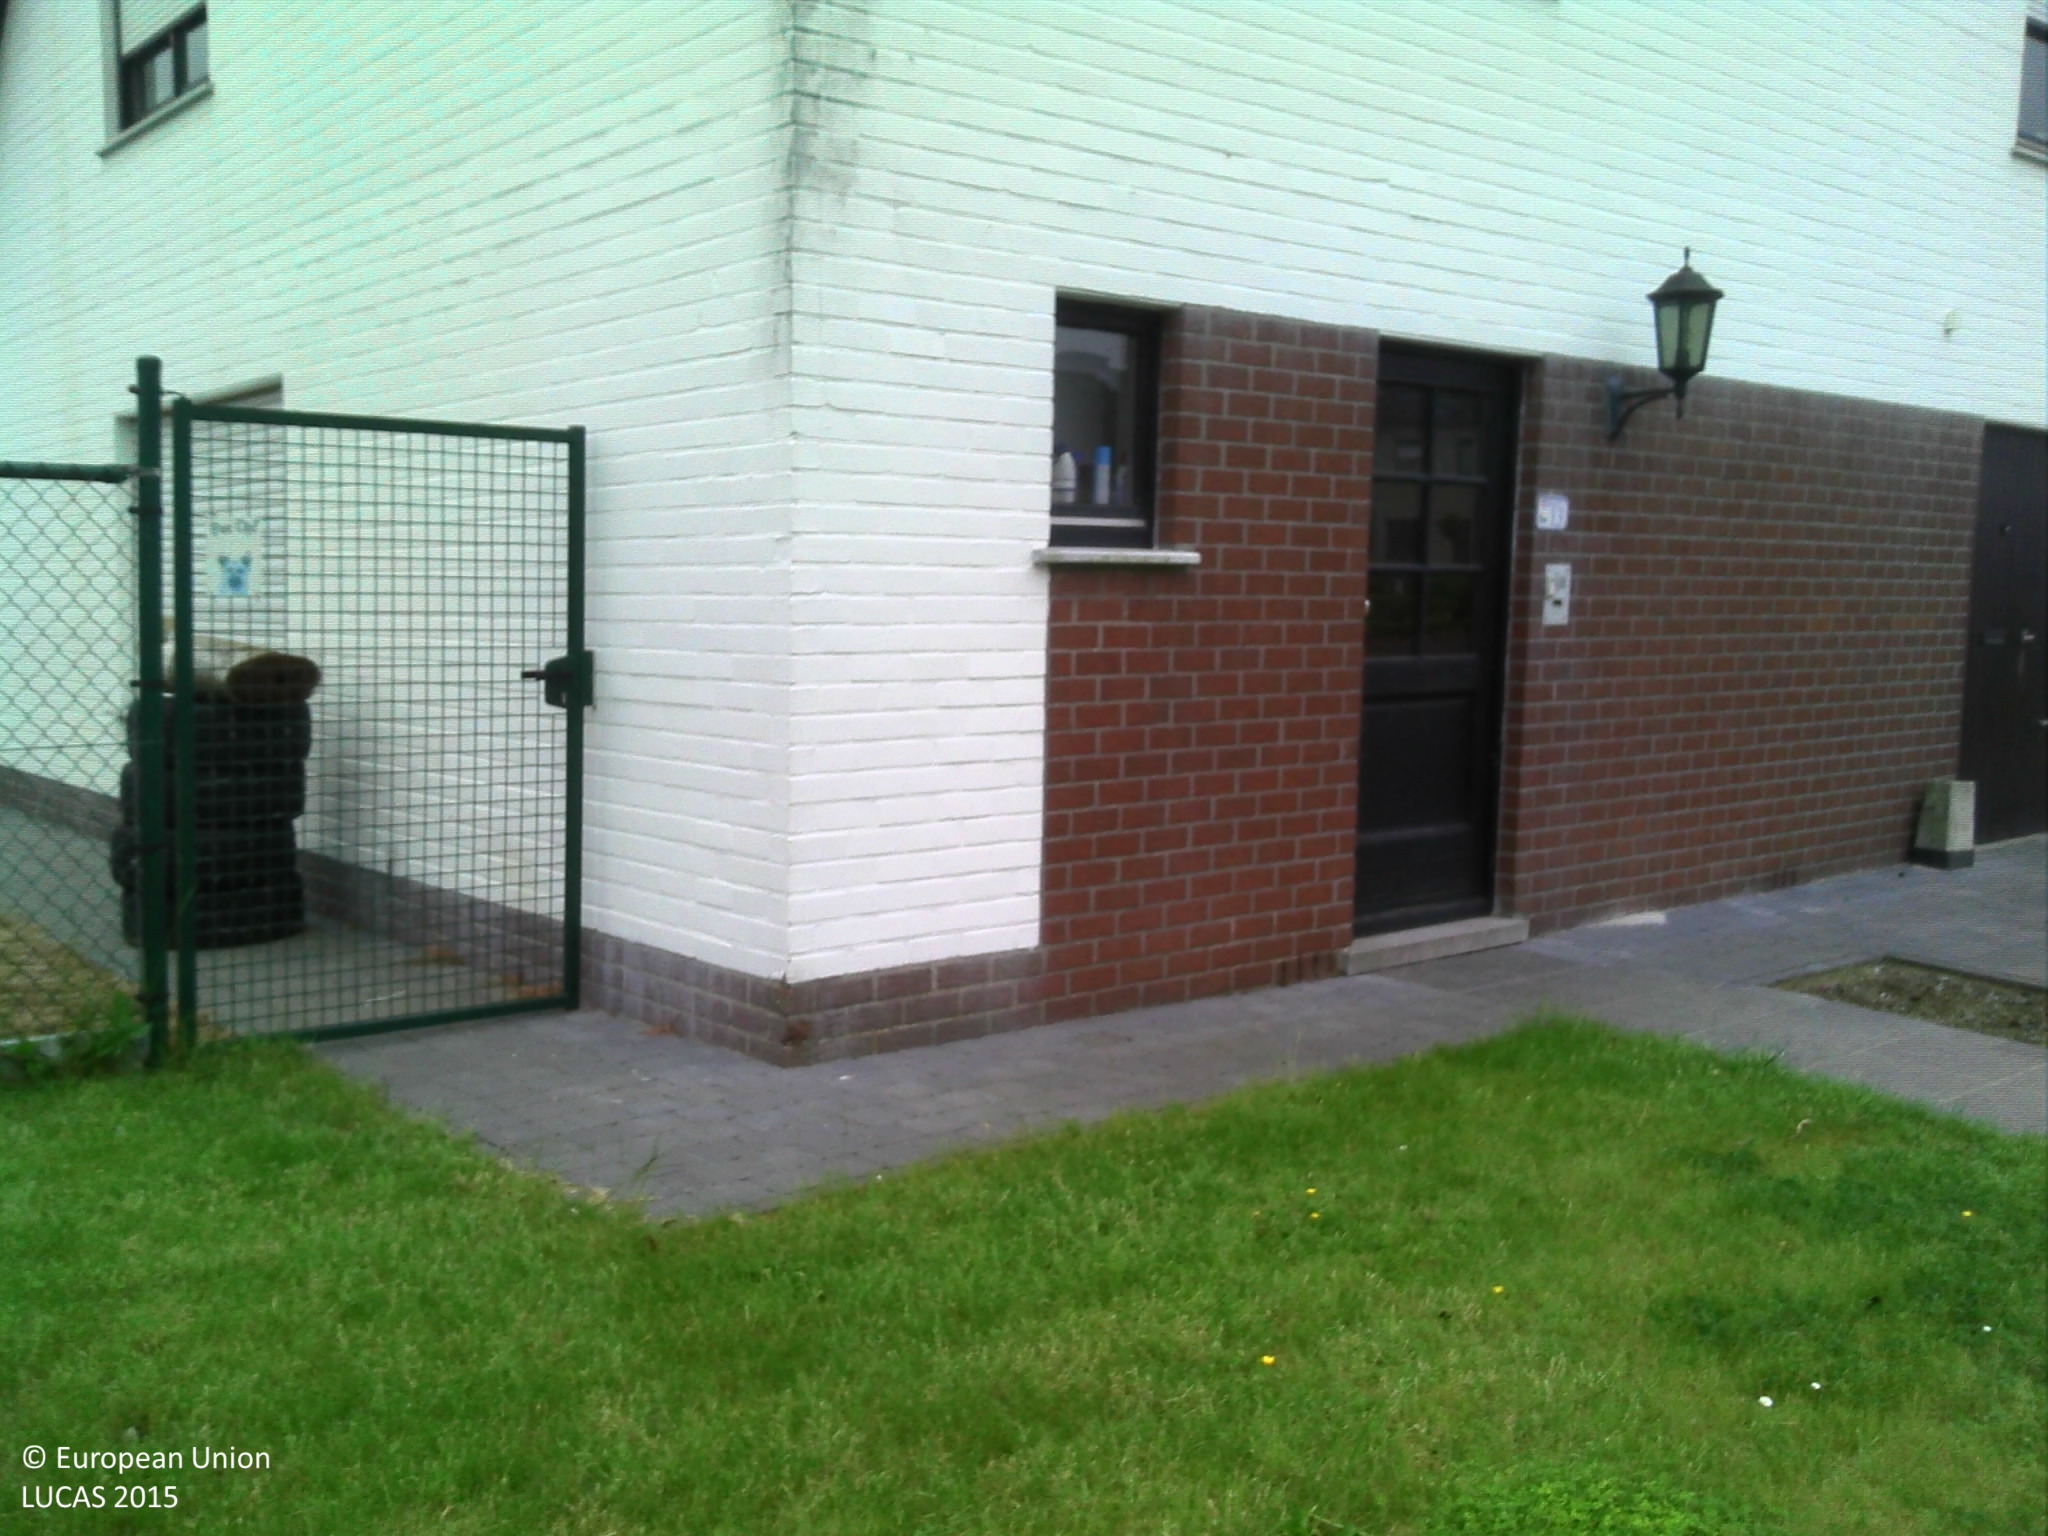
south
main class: Grassland
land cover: Grassland without tree/shrub cover
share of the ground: > 75 %
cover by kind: herbaceous plants 100 %
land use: Residential
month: June
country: BE
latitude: 50.8071
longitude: 3.7635
